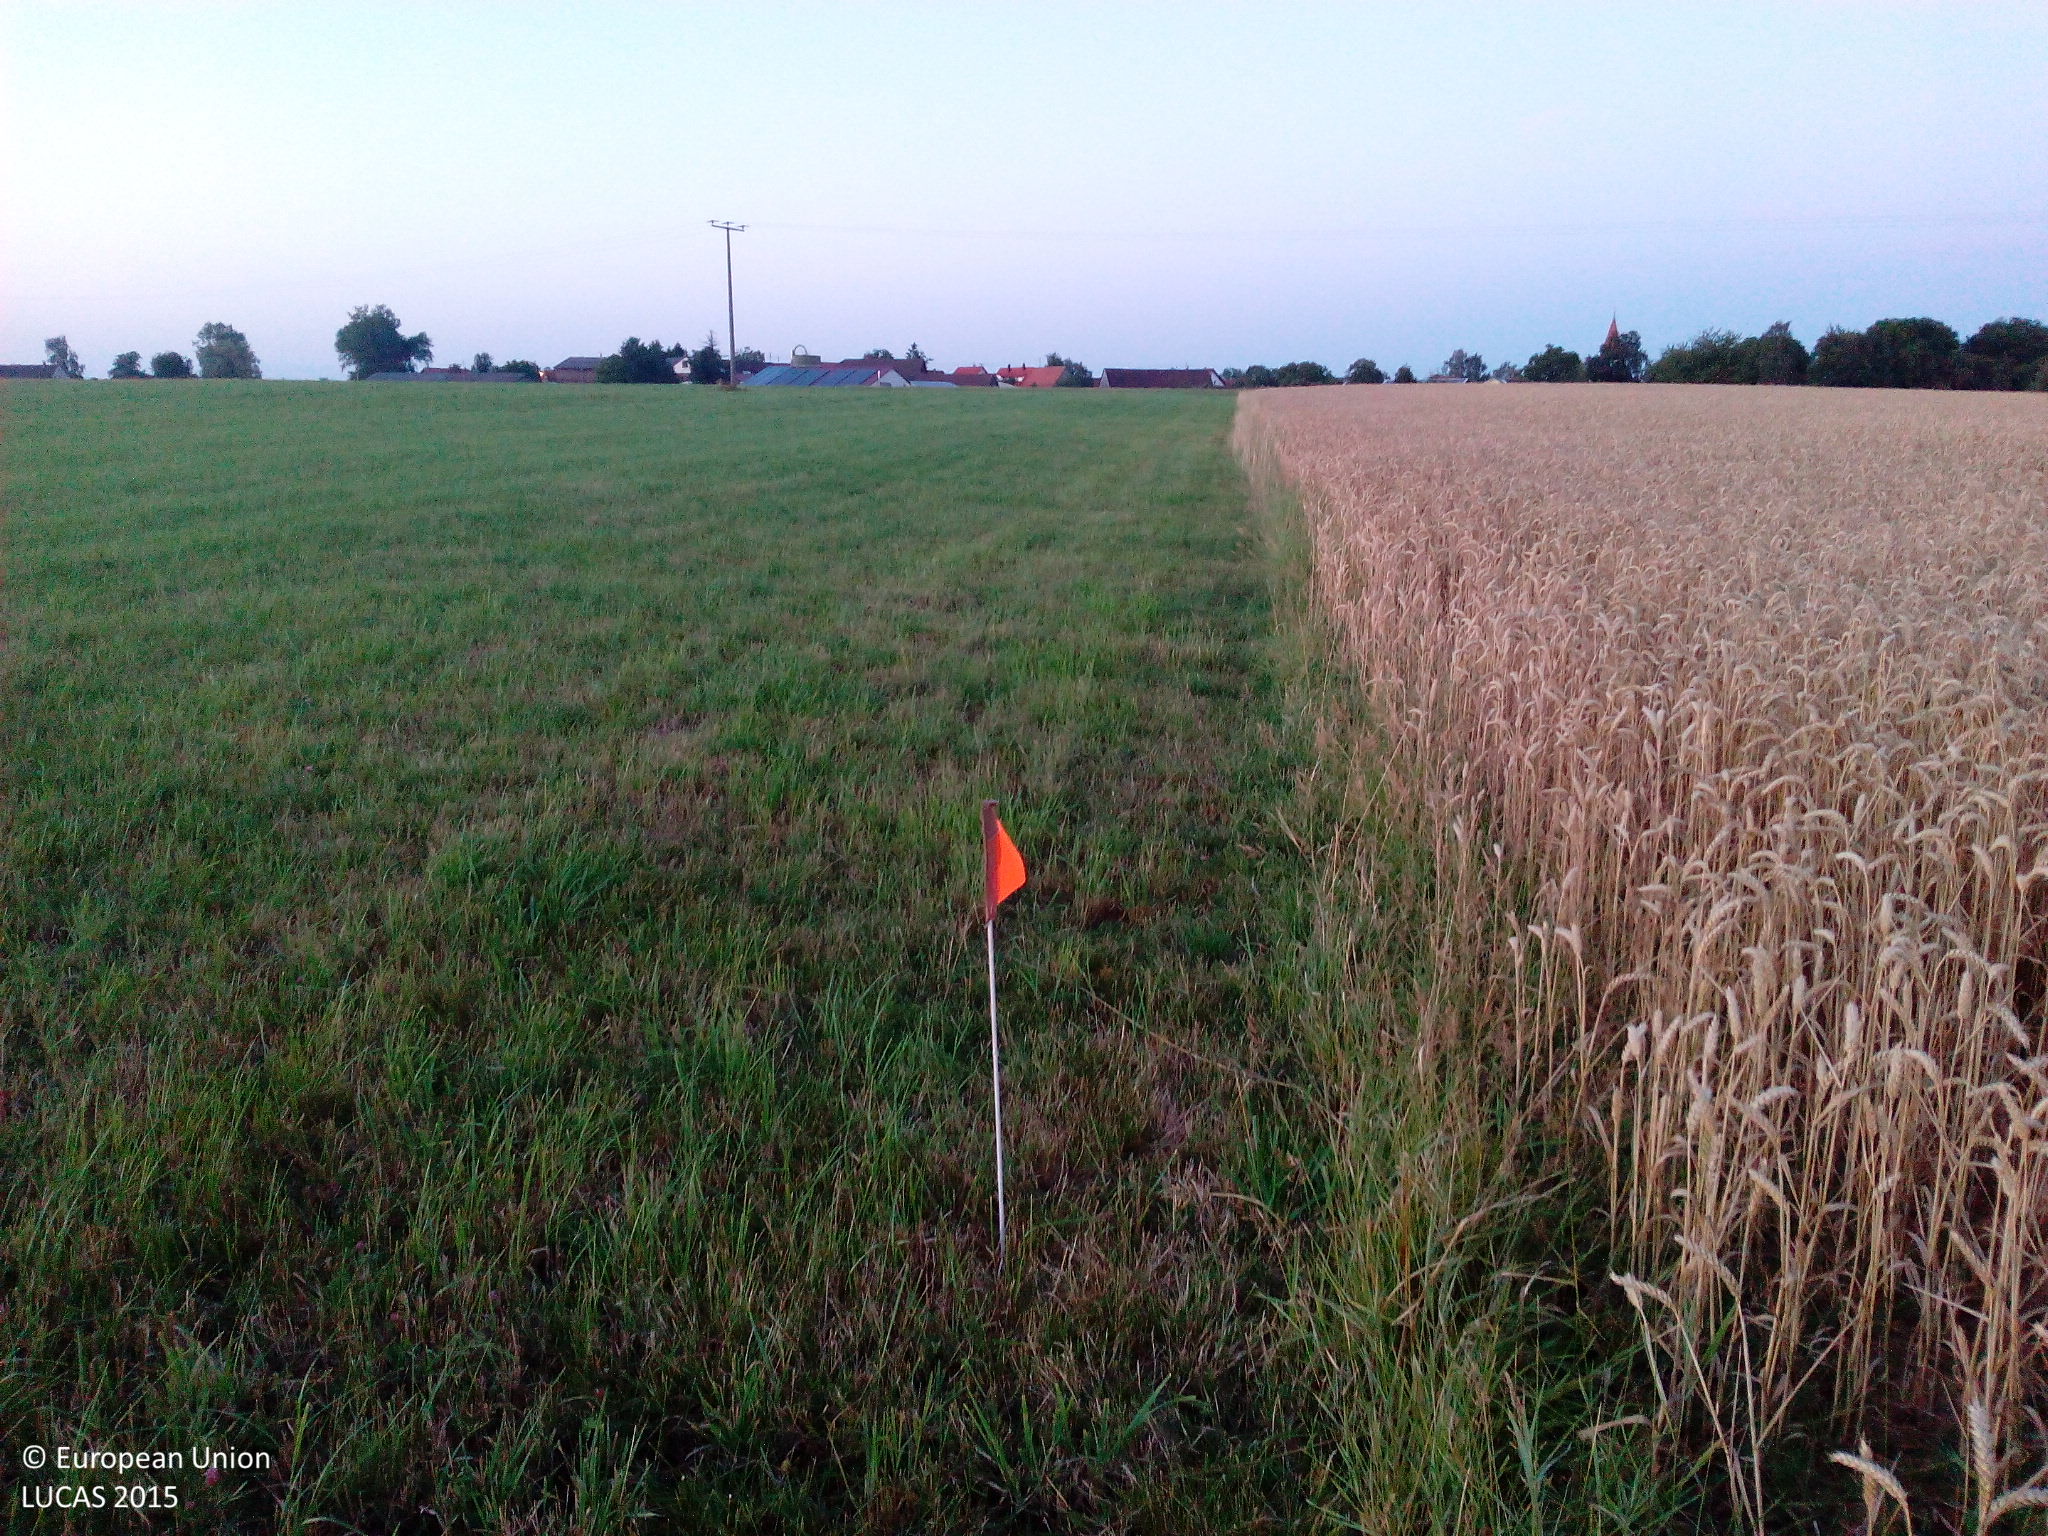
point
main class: Grassland
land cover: Grassland without tree/shrub cover
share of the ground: > 75 %
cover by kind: herbaceous plants 95 %, unconsolidated bare surface 5 %
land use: Agriculture (excluding fallow land and kitchen gardens)
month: July
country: DE
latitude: 48.9428
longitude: 10.3139
